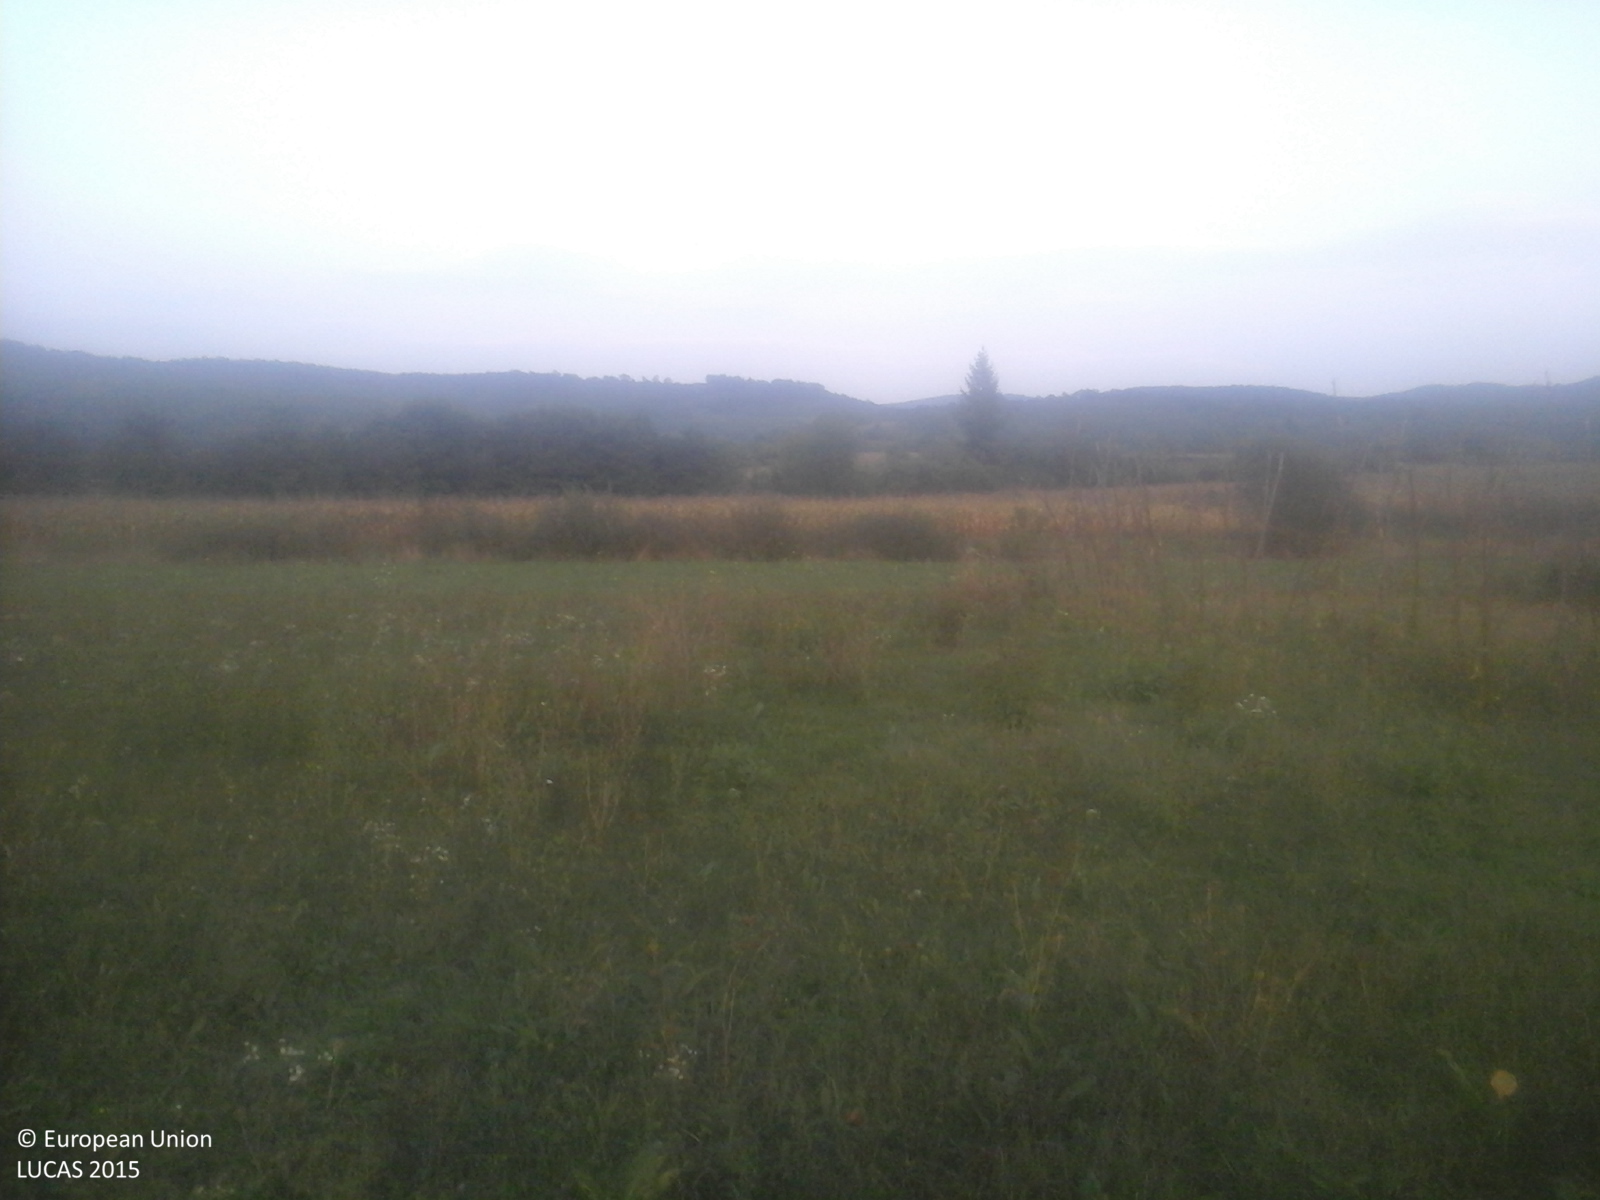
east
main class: Grassland
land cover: Spontaneously vegetated surfaces
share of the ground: > 75 %
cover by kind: herbaceous plants 100 %
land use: Fallow land
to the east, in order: Spontaneously vegetated surfaces; Other fresh vegetables; Other leguminous and mixtures for fodder; Abandoned hedges; Ditches and canals; Spontaneously vegetated surfaces; Maize; Shruby margins; Lucerne; Spontaneously vegetated surfaces; Other fresh vegetables; Abandoned hedges; Spontaneously vegetated surfaces; Artificial constructions in urban areas; Other fruit trees and berries
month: September
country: RO
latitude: 45.7007
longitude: 22.0750
